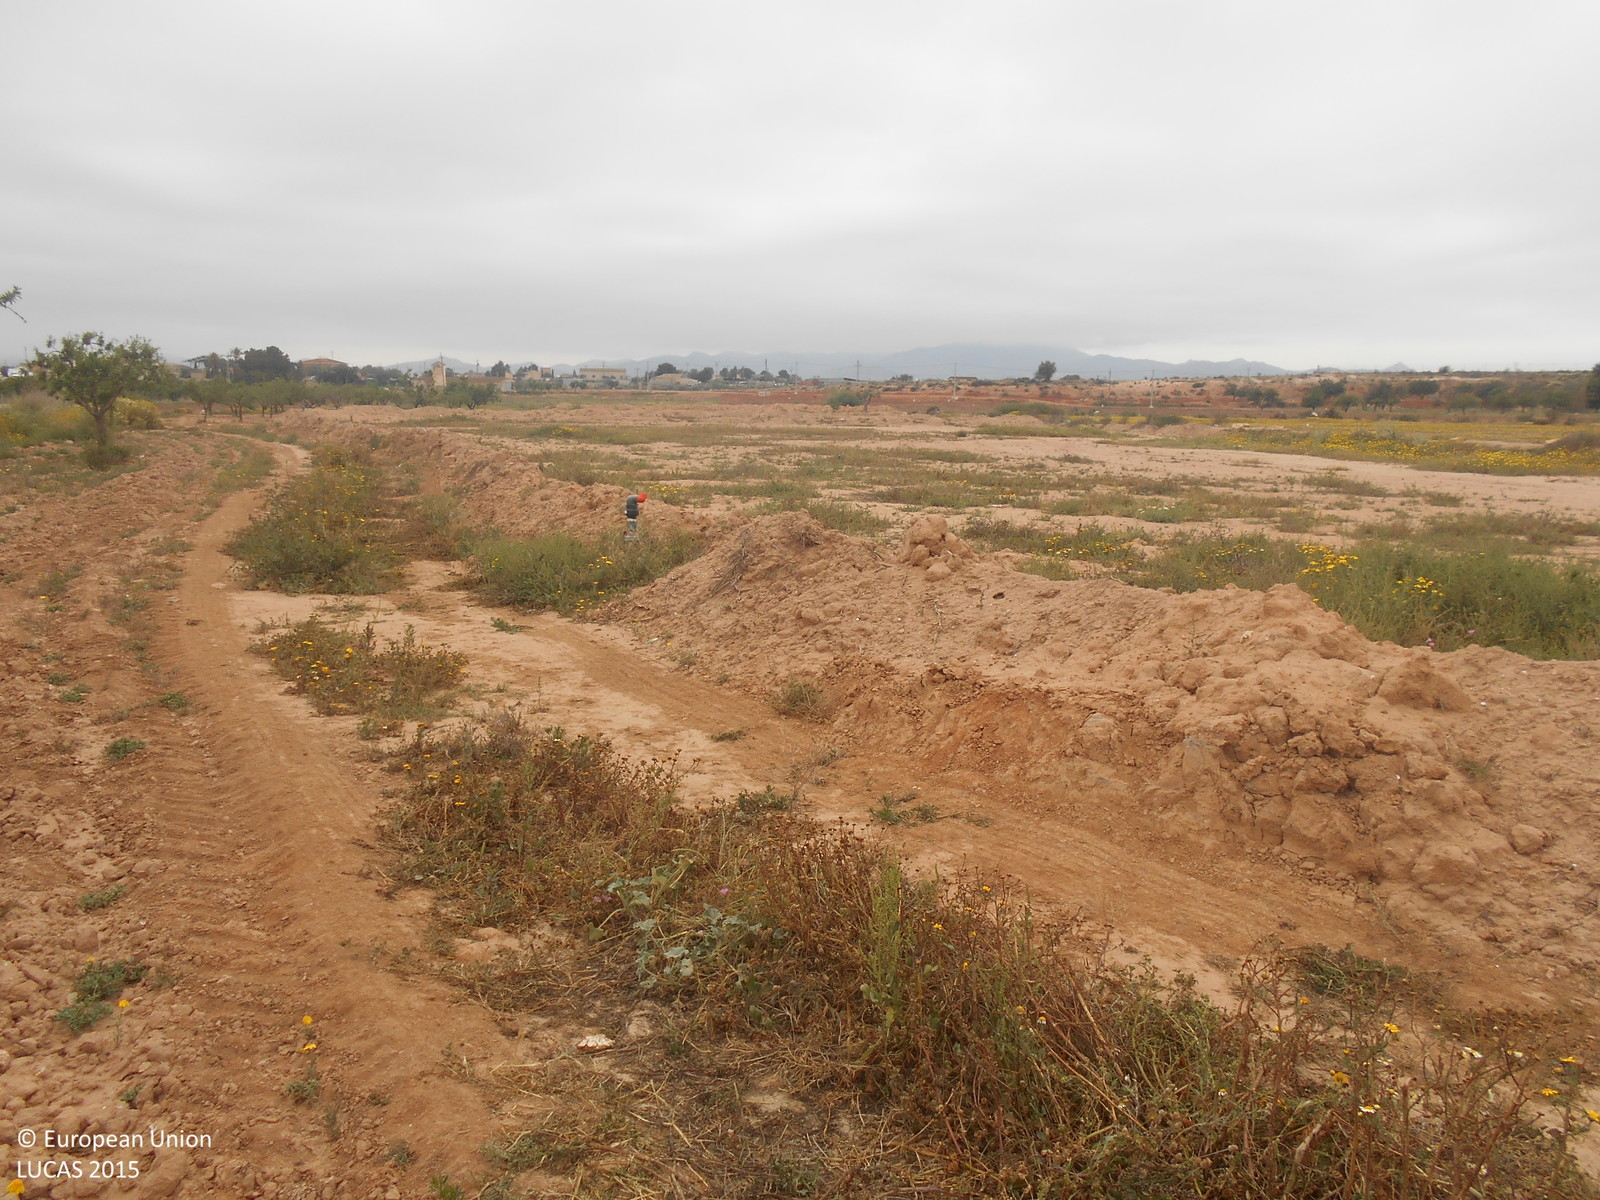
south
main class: Cropland
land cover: Nuts trees
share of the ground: 10 - 25 %
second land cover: Spontaneously vegetated surfaces
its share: 25 - 50 %
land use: Agriculture (excluding fallow land and kitchen gardens)
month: April
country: ES
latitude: 37.7364
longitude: -1.2492
